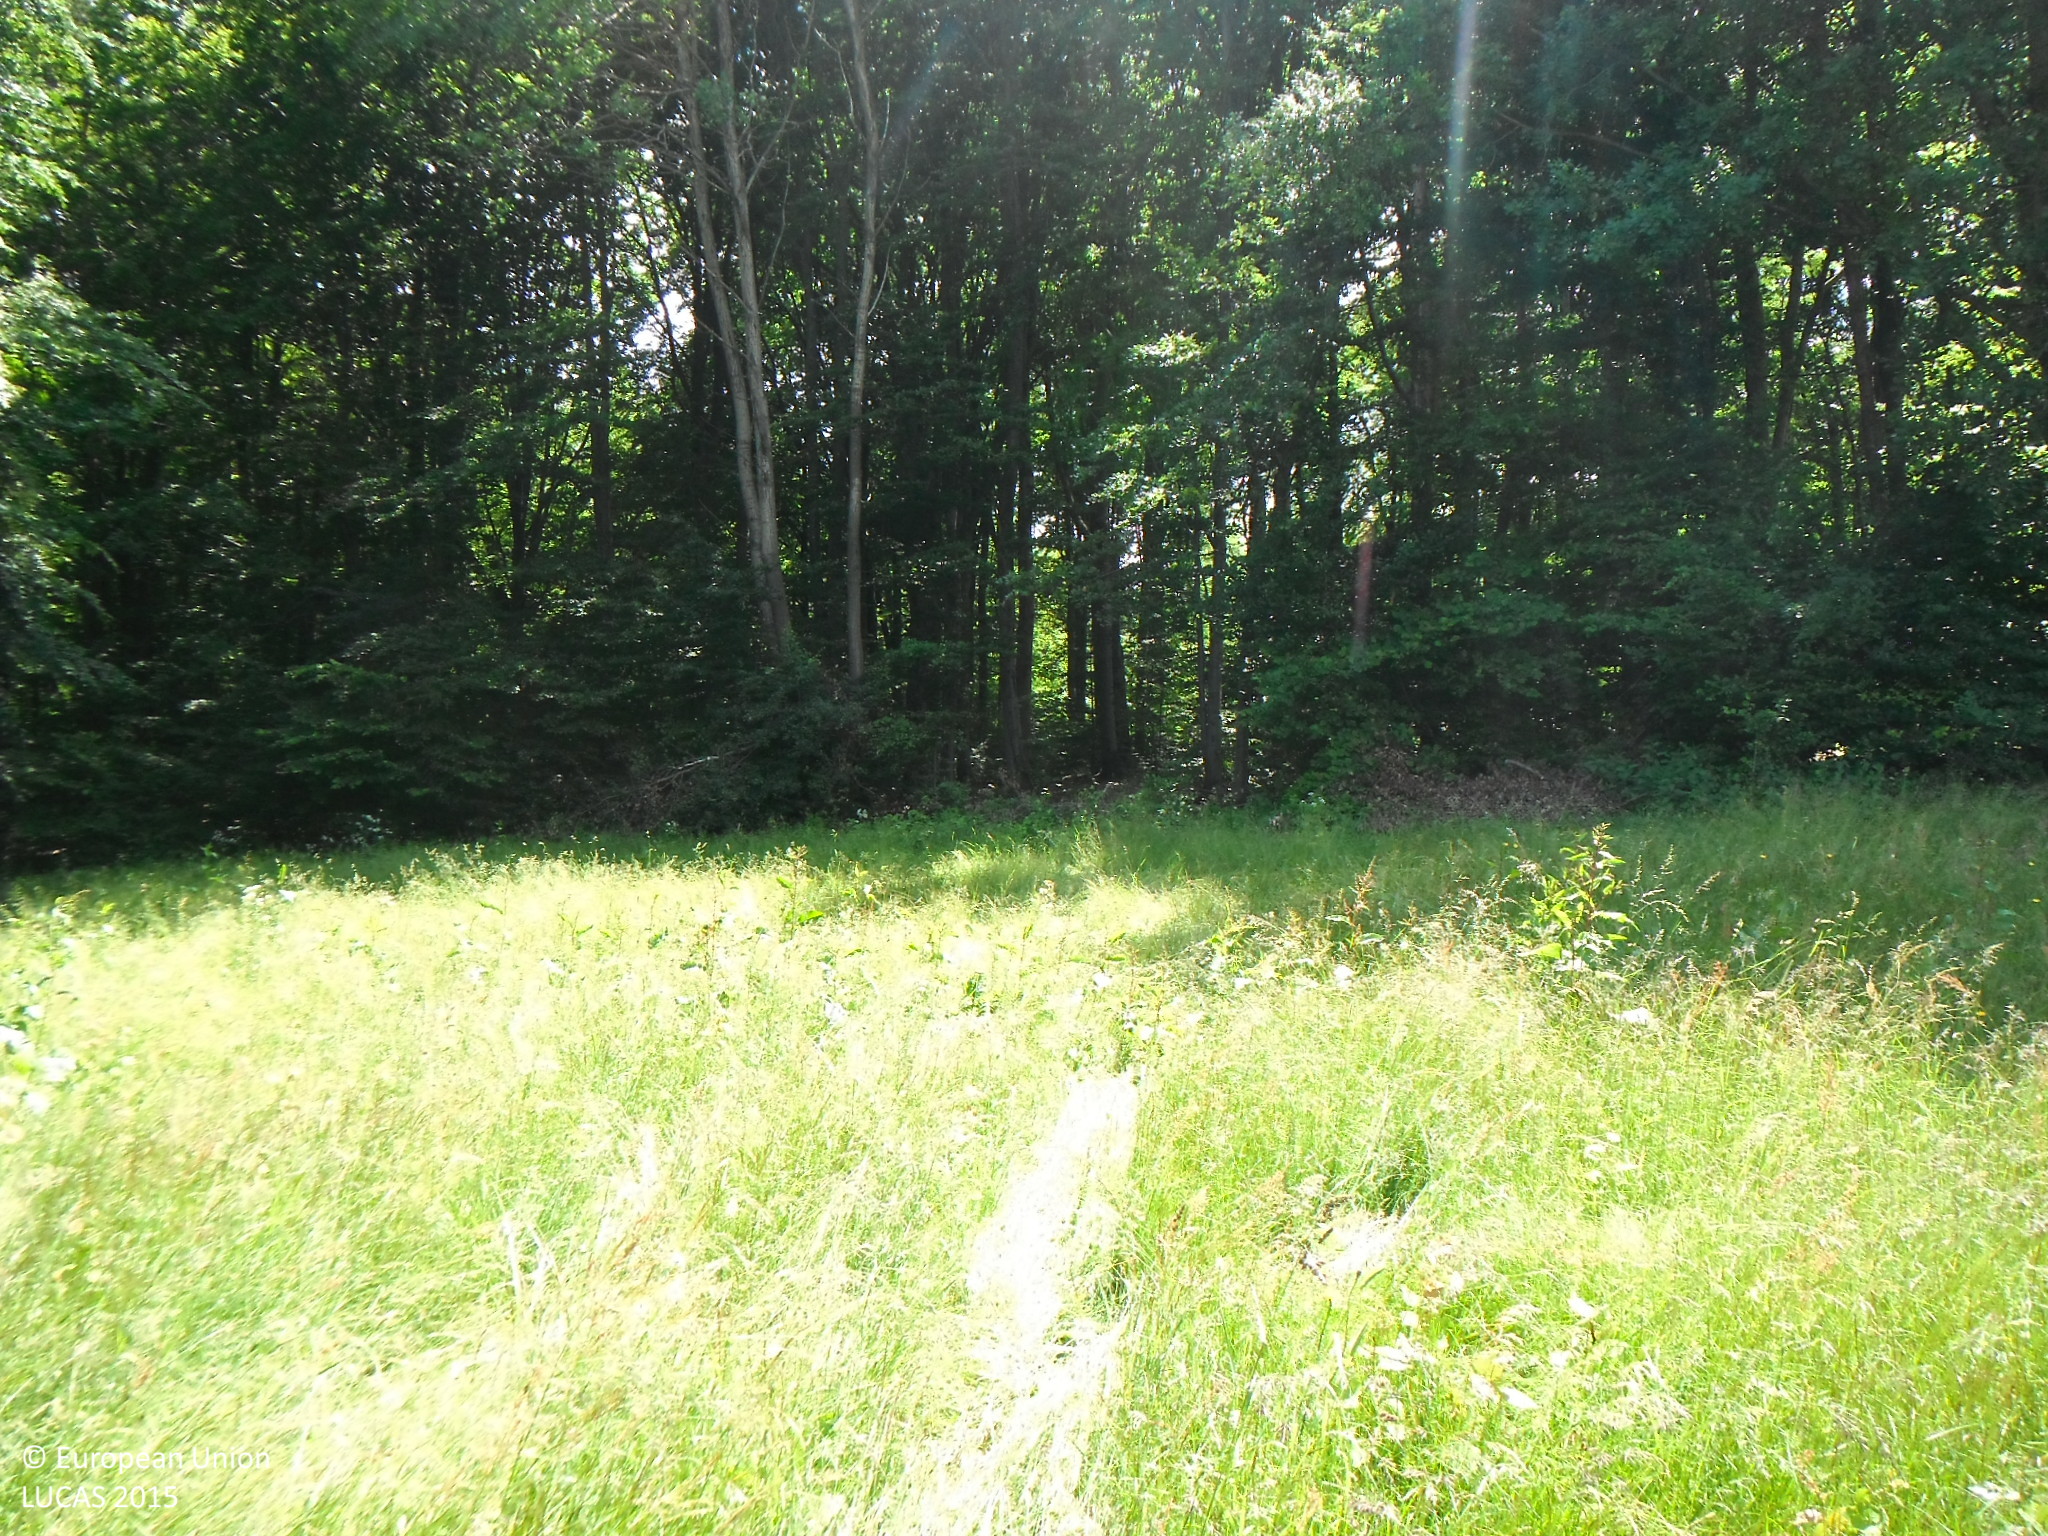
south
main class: Grassland
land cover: Grassland without tree/shrub cover
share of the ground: > 75 %
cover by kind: herbaceous plants 100 %
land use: Agriculture (excluding fallow land and kitchen gardens)
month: June
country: SK
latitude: 48.9186
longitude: 21.0552
